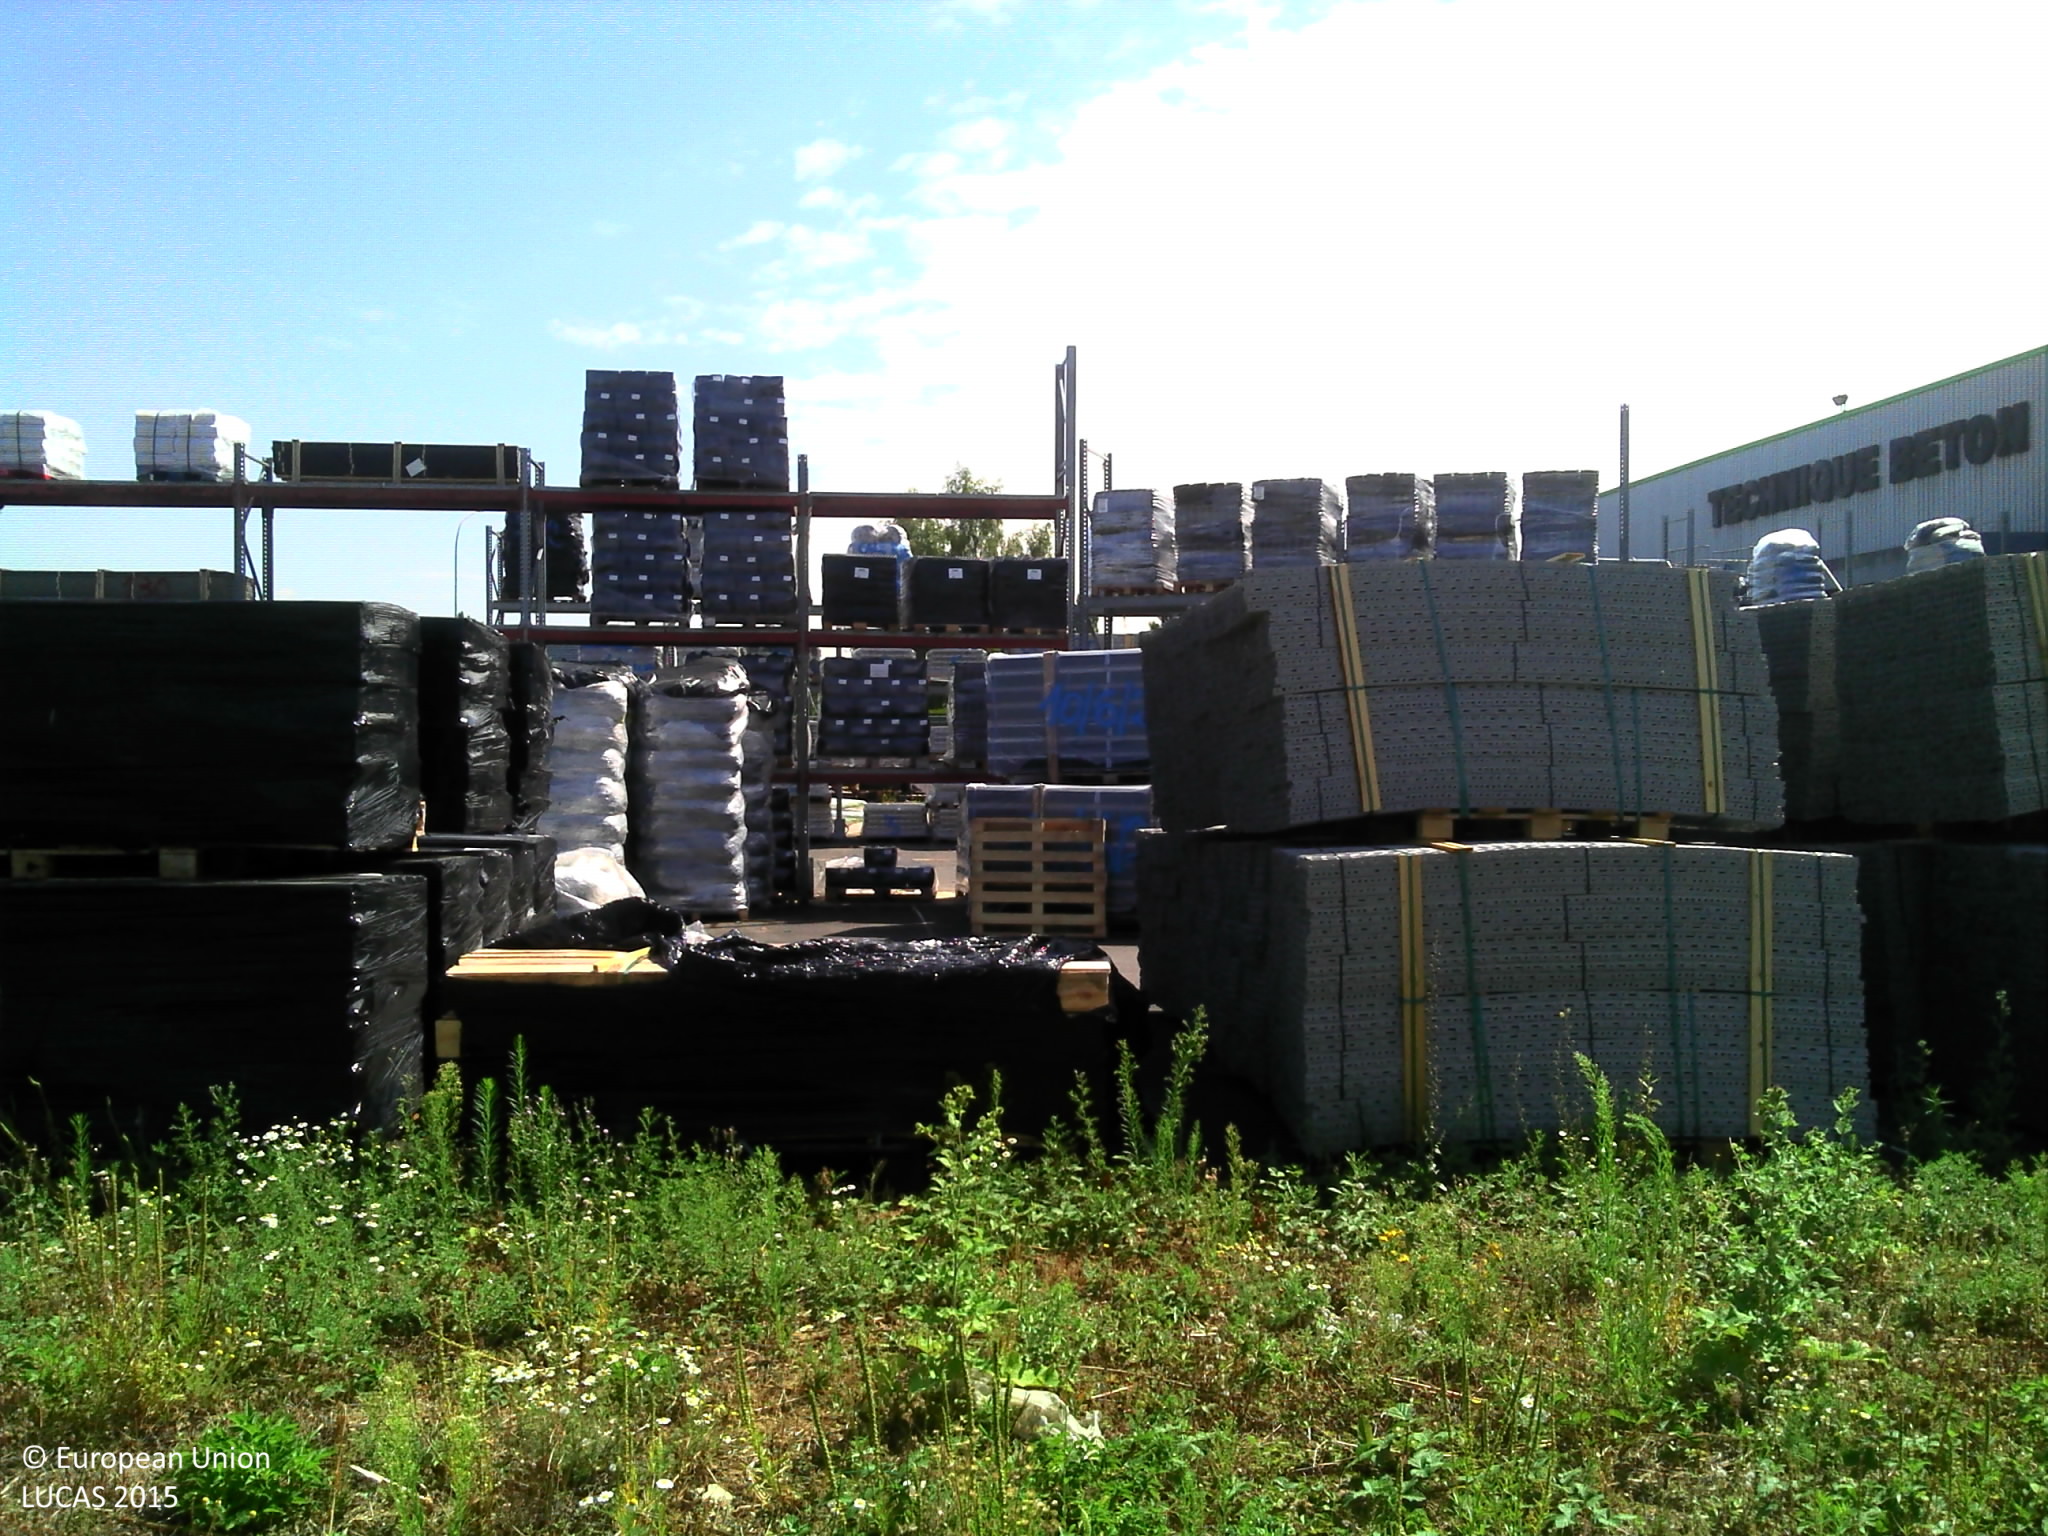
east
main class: Grassland
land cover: Spontaneously vegetated surfaces
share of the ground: > 75 %
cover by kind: herbaceous plants 90 %, consolidated bare surface 10 %
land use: Logistics and storage
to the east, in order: Spontaneously vegetated surfaces; Artificial constructions in urban areas
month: July
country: FR
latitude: 48.6230
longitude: 2.5686
